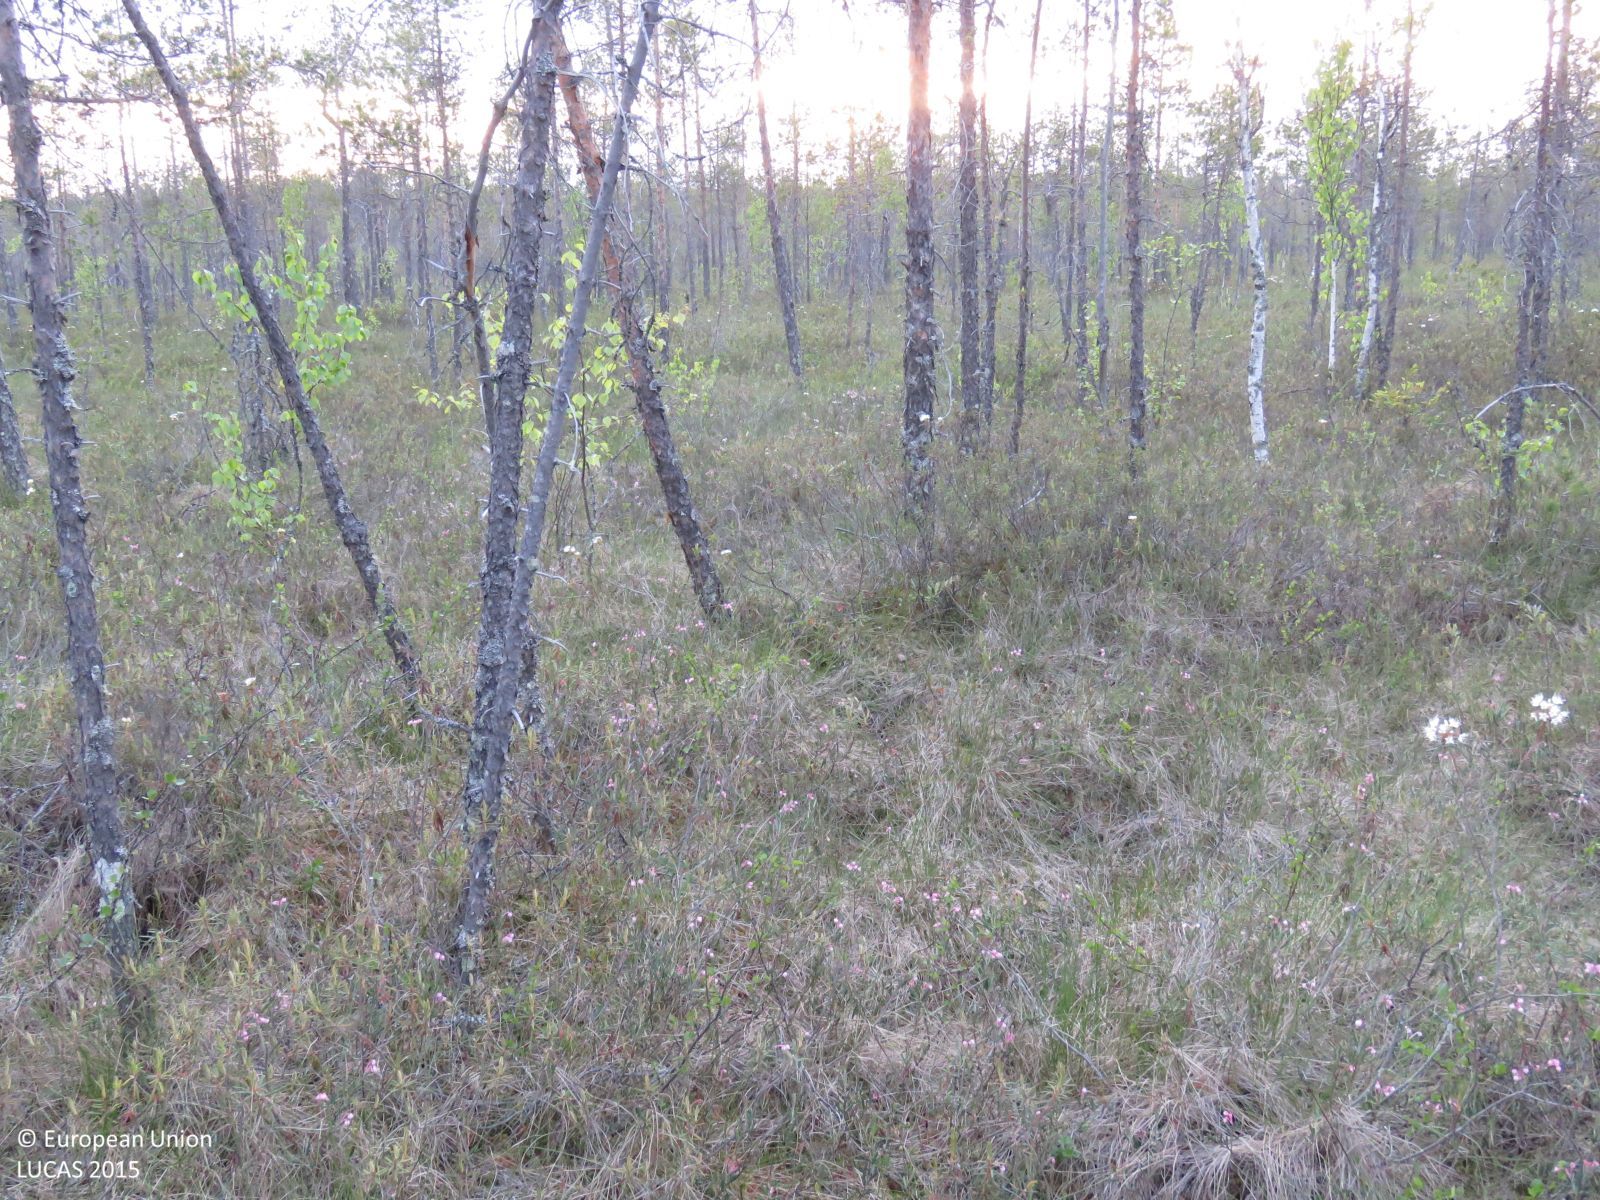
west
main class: Woodland
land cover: Pine dominated coniferous woodland
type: mire and swamp forests
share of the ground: 25 - 50 %
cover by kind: shrubs 55 %, coniferous forest trees 30 %, broadleaved forest trees 5 %, herbaceous plants 5 %, lichens and mosses 5 %
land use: Forestry
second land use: Amenities, museums, leisure
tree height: > 5 m
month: June
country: FI
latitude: 64.8076
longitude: 26.2969
